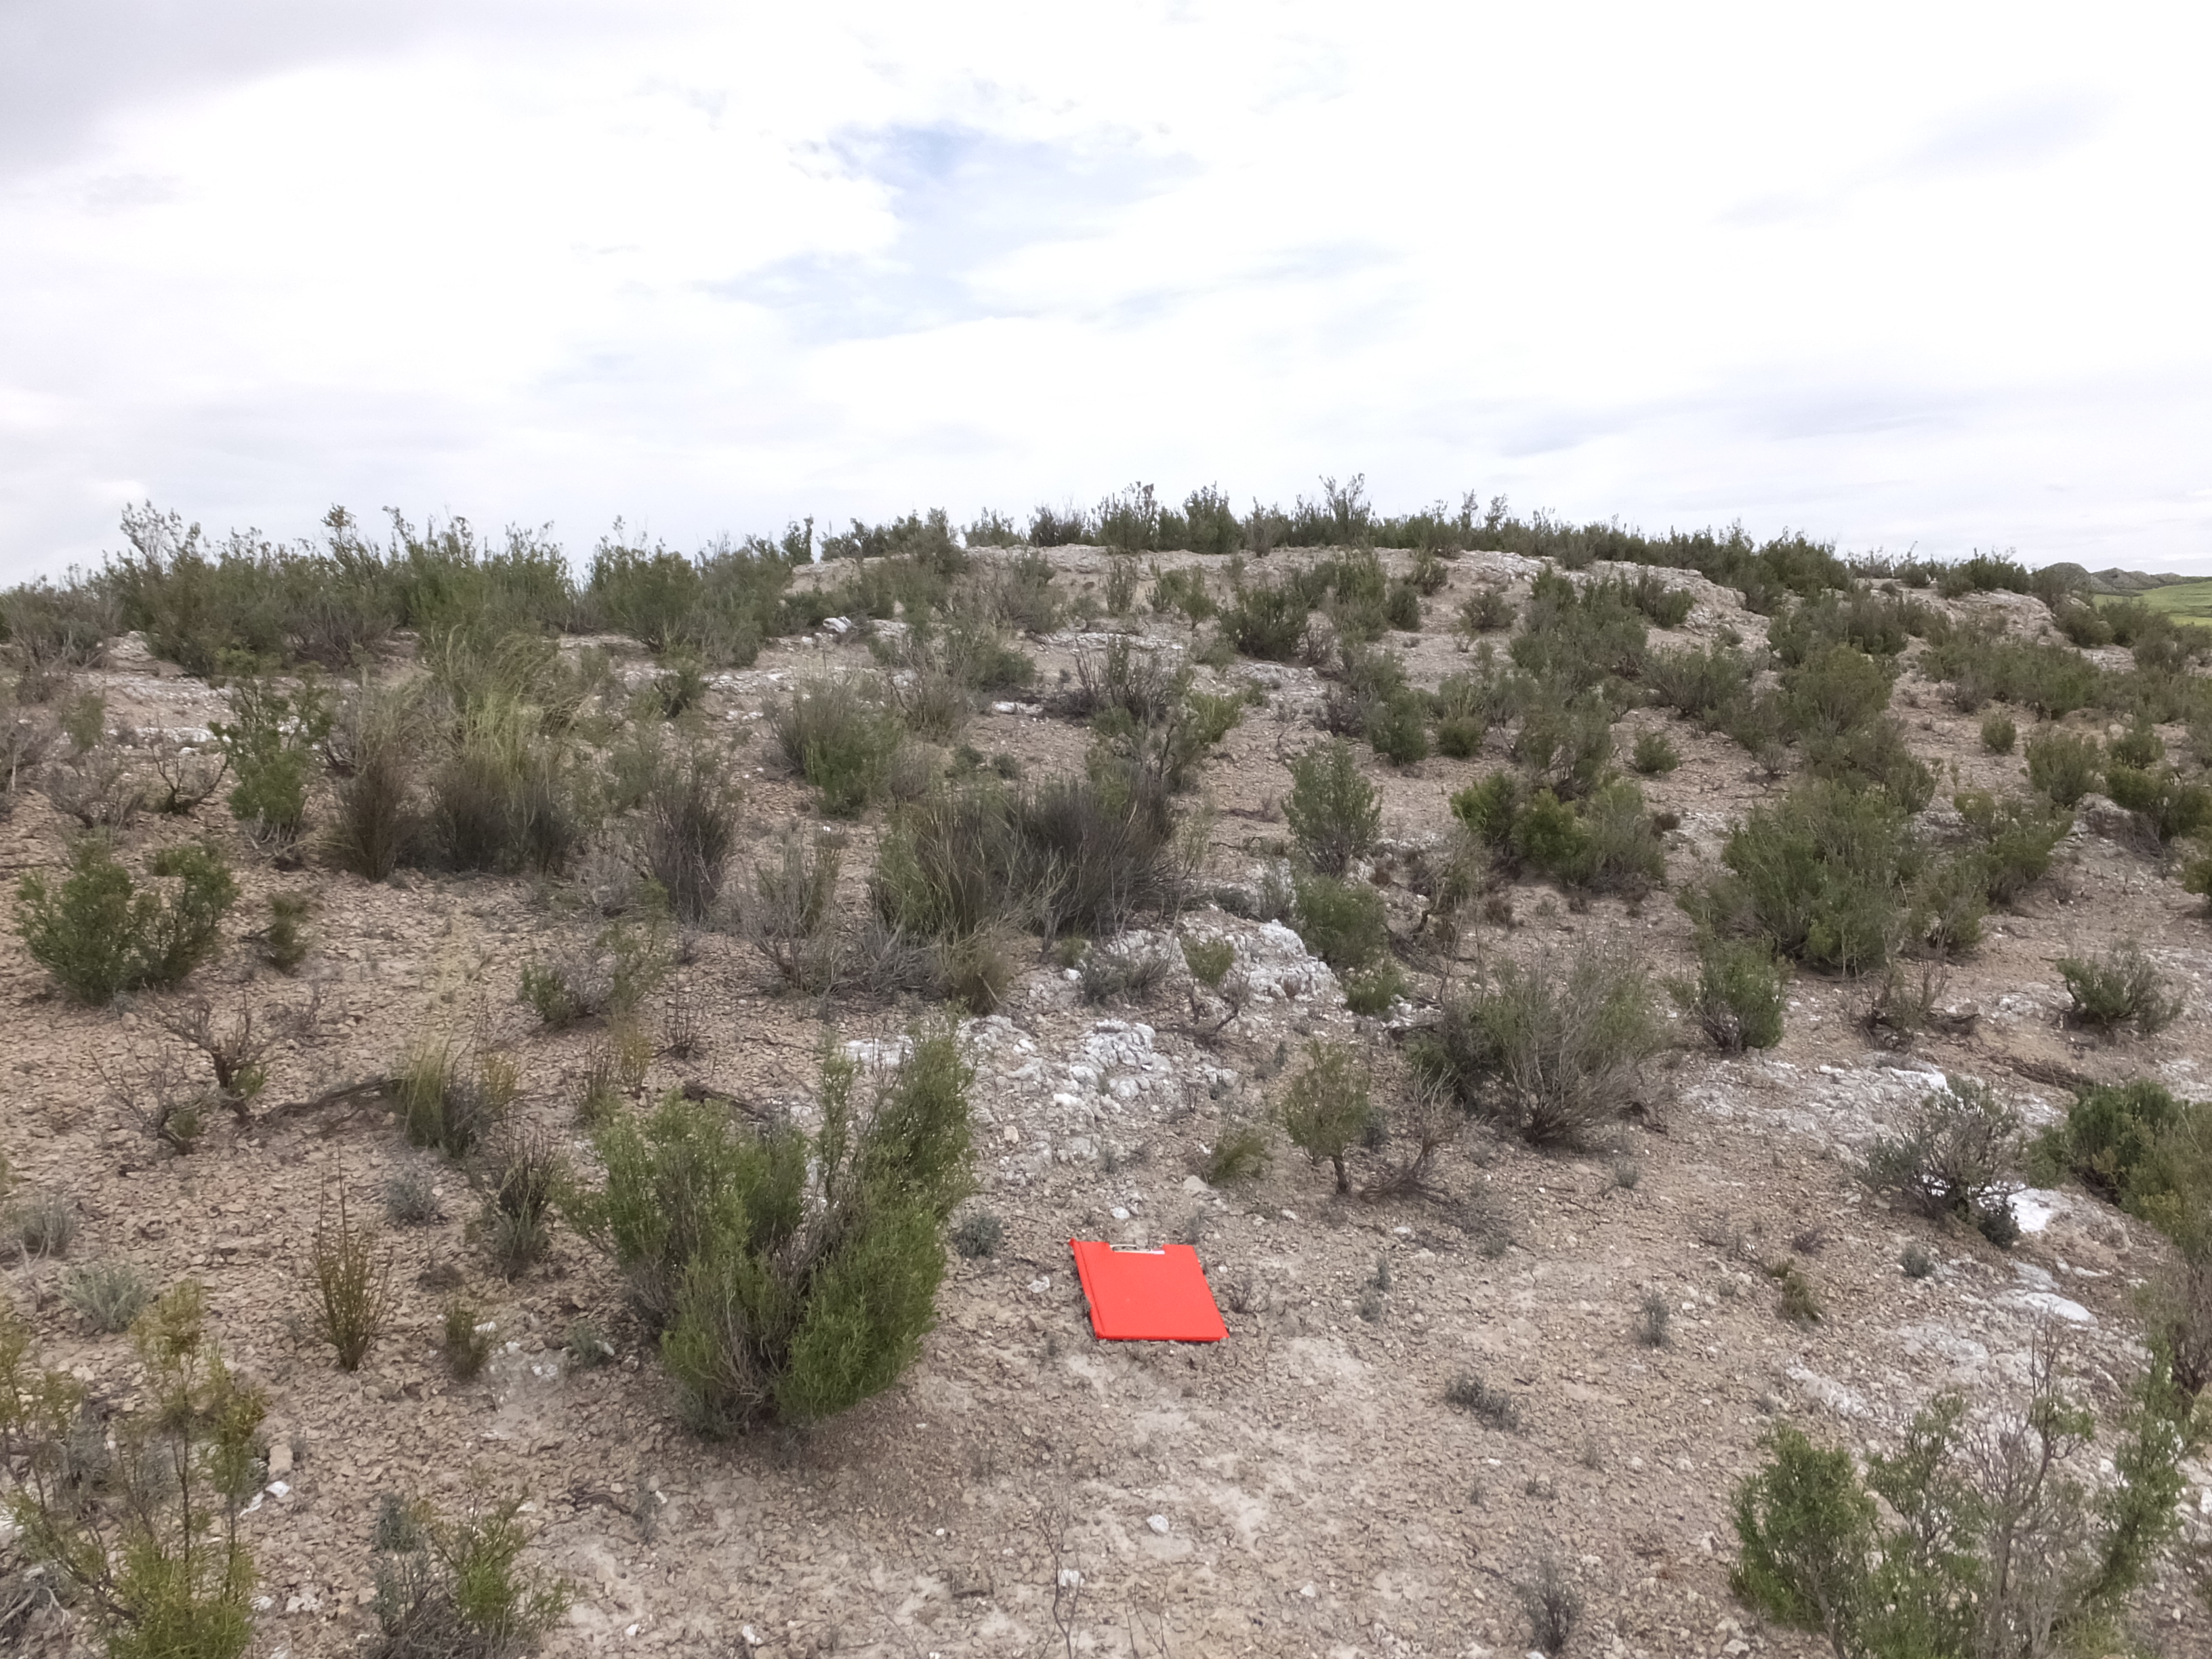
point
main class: Shrubland
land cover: Shrubland without tree cover
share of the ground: 25 - 50 %
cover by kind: shrubs 40 %, consolidated bare surface 35 %, herbaceous plants 25 %
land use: Semi-natural and natural areas not in use
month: May
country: ES
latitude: 41.4852
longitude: -0.3525
